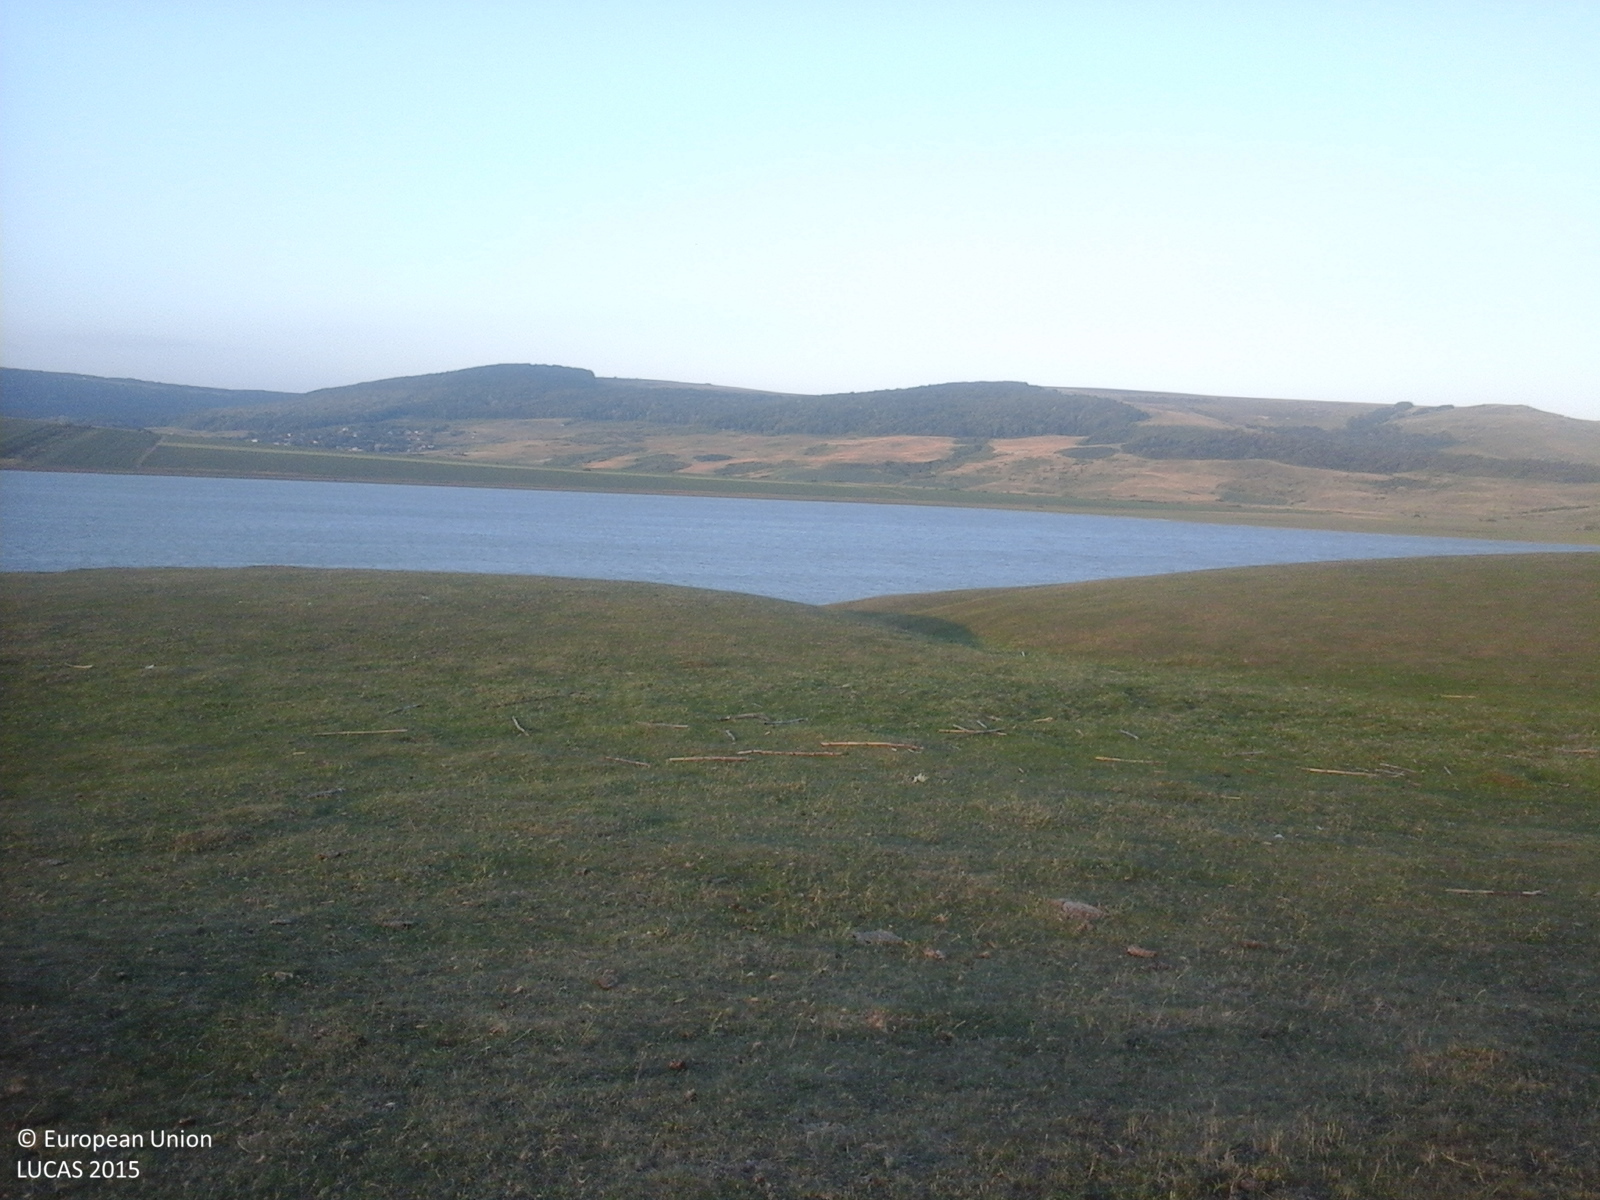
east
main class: Grassland
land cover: Grassland without tree/shrub cover
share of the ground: > 75 %
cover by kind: herbaceous plants 100 %
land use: Agriculture (excluding fallow land and kitchen gardens)
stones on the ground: < 10 %
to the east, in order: Grassland without tree/shrub cover; Inland fresh water bodies
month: June
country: RO
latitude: 46.9467
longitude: 27.3331
